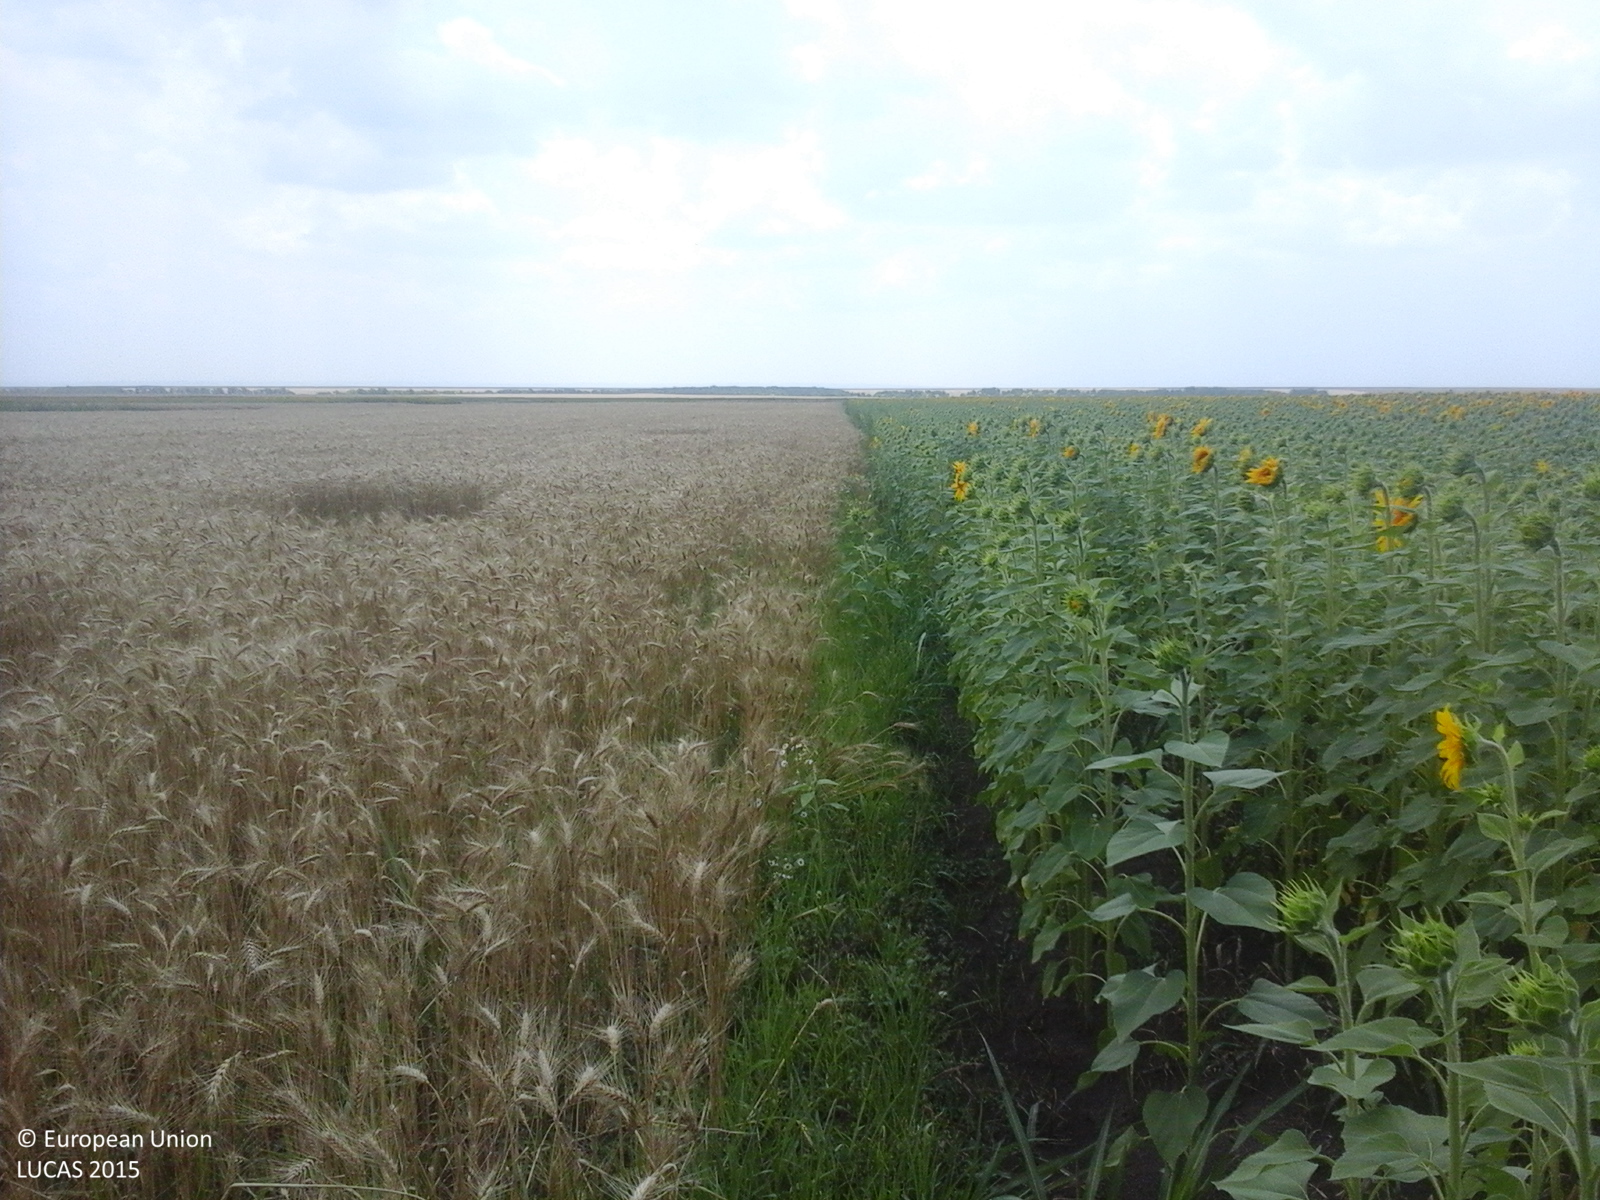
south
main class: Cropland
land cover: Sunflower
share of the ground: > 75 %
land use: Agriculture (excluding fallow land and kitchen gardens)
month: July
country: RO
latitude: 43.8902
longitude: 25.6362
